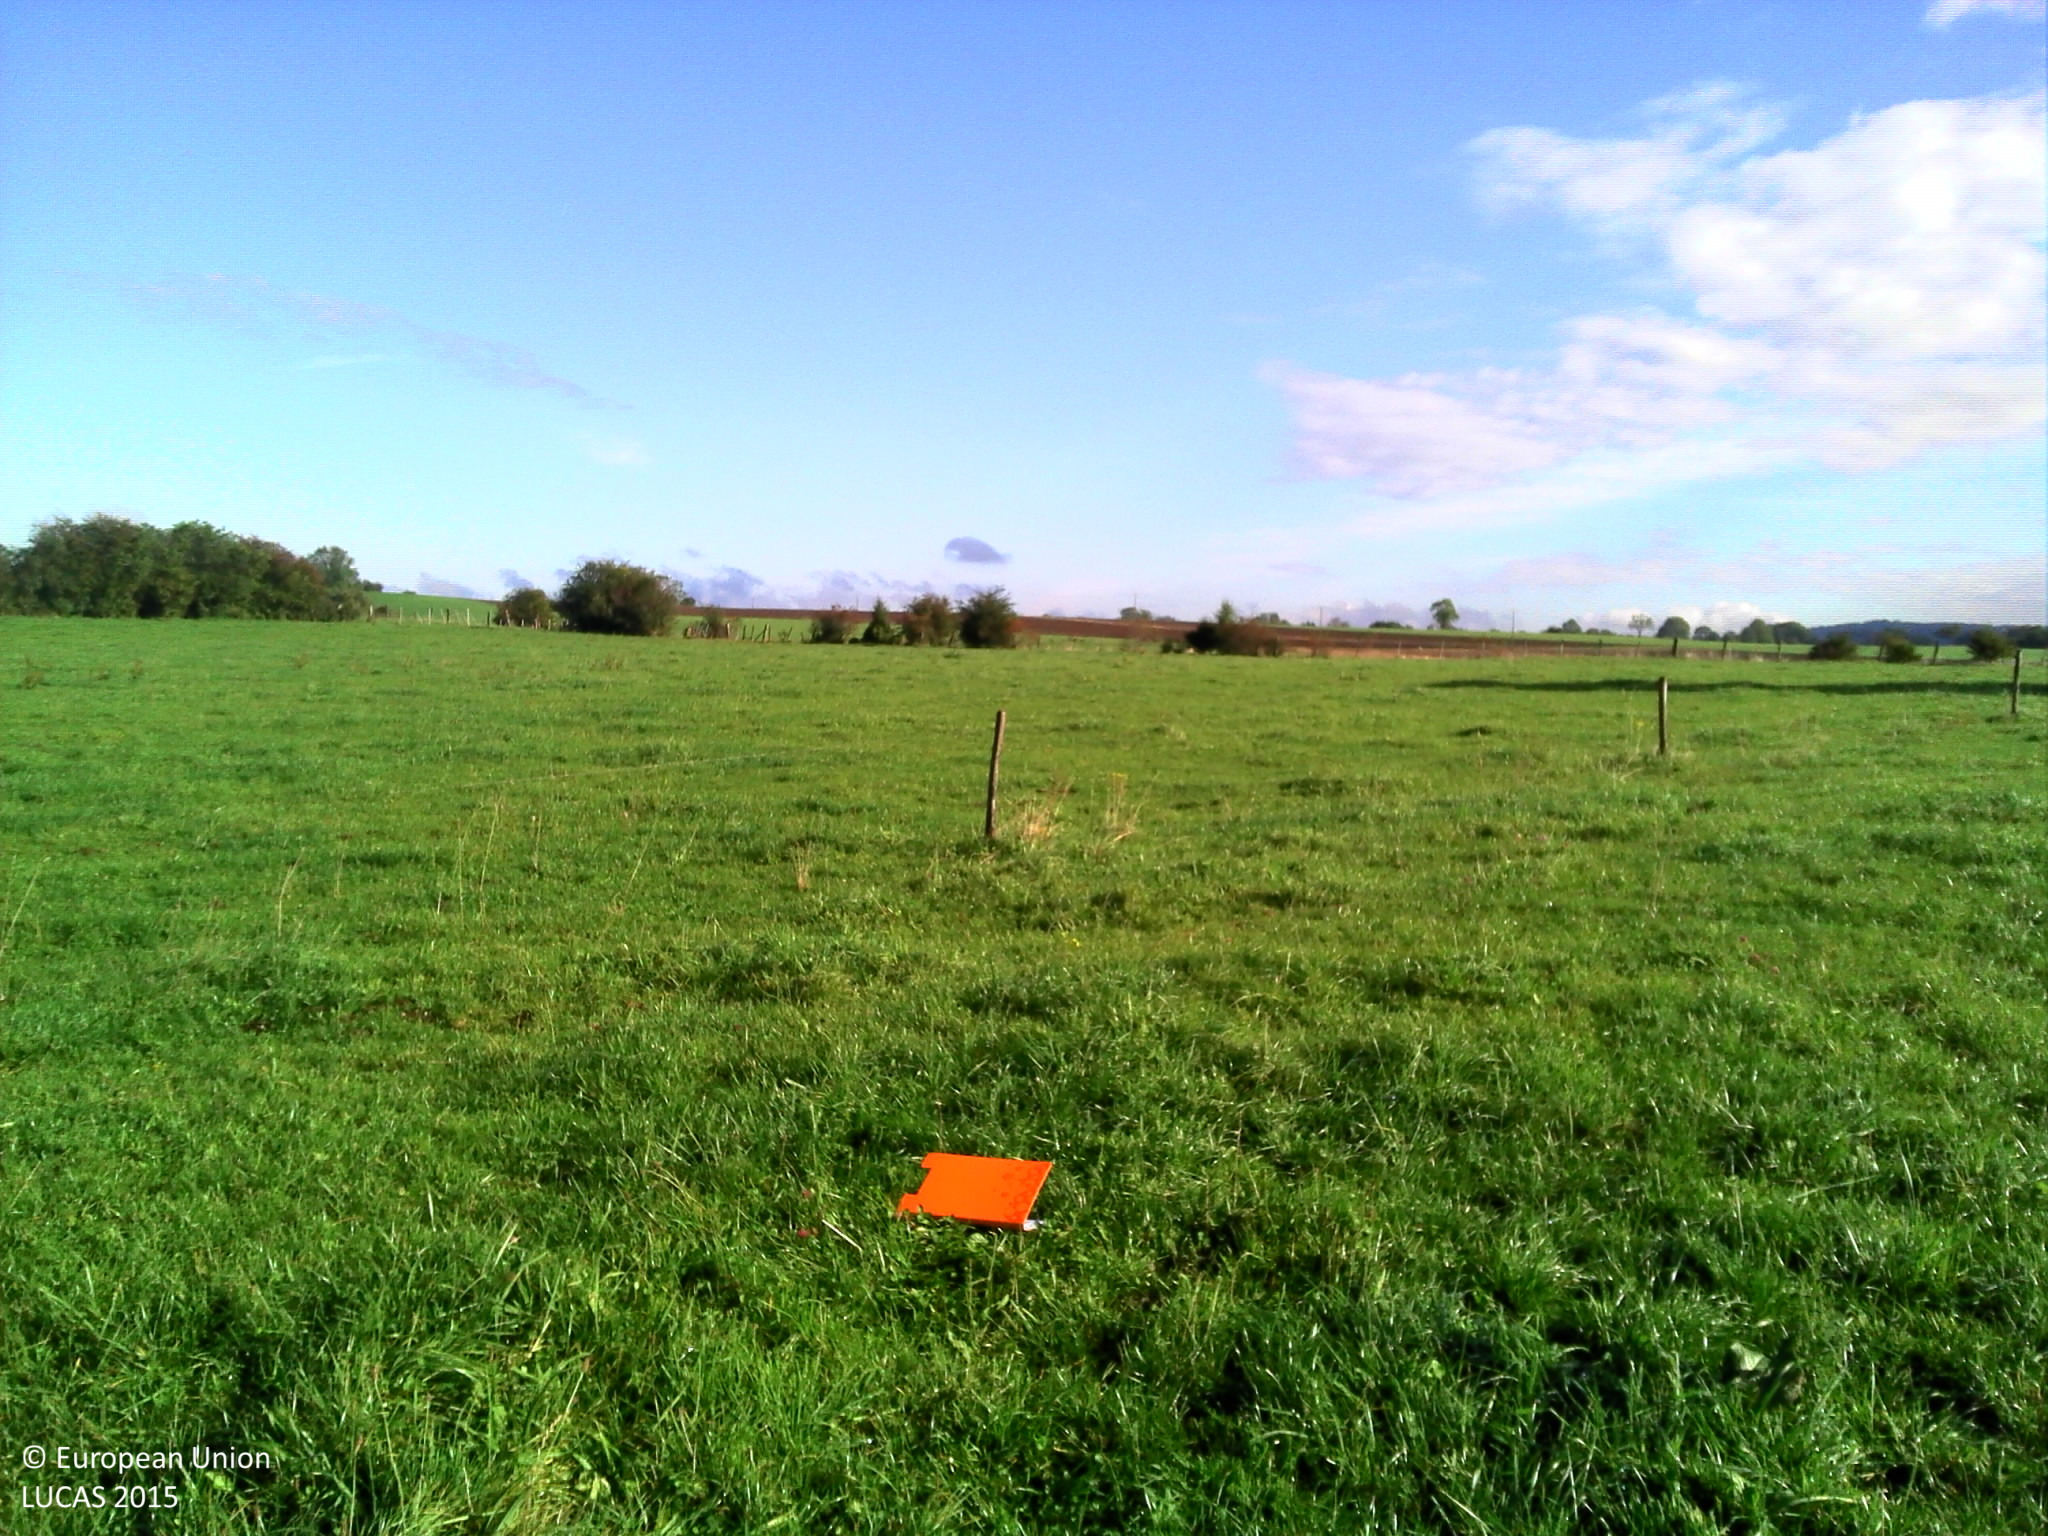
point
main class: Grassland
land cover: Grassland with sparse tree/shrub cover
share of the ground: > 75 %
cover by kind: herbaceous plants 95 %, broadleaved forest trees 5 %
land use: Agriculture (excluding fallow land and kitchen gardens)
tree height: > 5 m
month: September
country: FR
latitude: 47.1182
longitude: 6.3512
